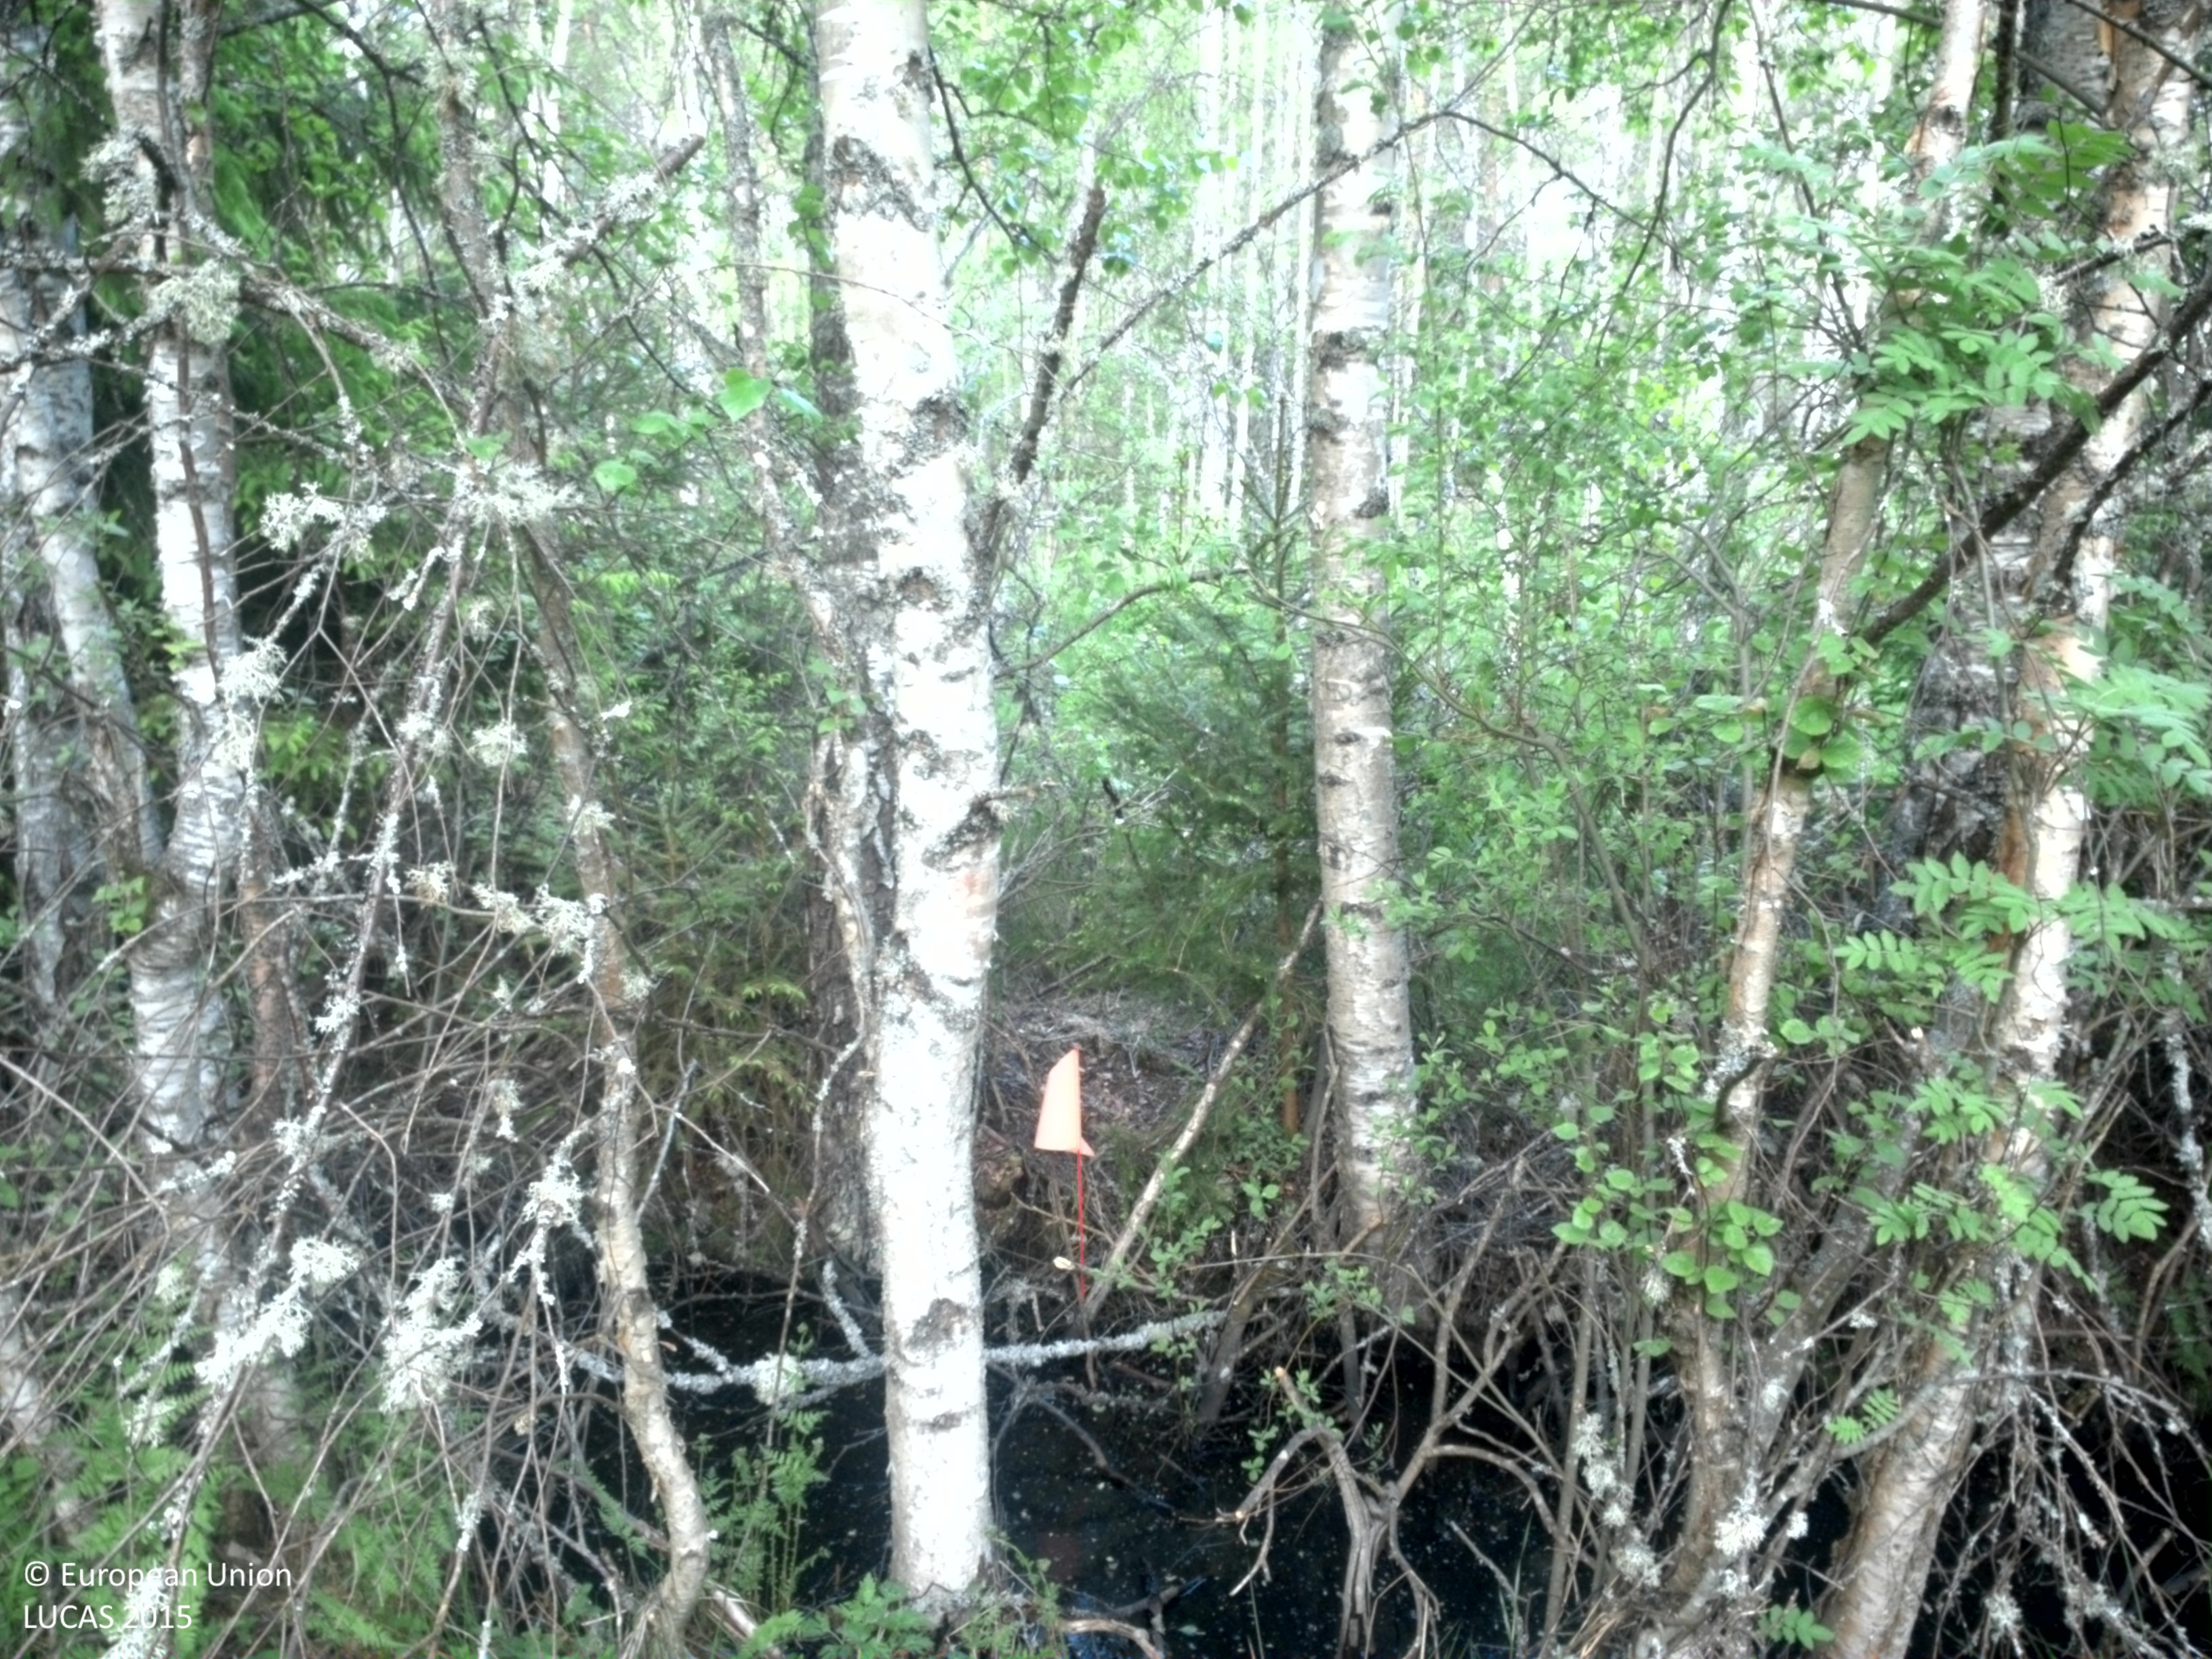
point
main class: Woodland
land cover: Broadleaved woodland
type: boreal forest
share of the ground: 50 - 75 %
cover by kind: broadleaved forest trees 50 %, herbaceous plants 15 %, lichens and mosses 15 %, coniferous forest trees 10 %, shrubs 10 %
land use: Forestry
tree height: > 5 m
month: May
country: SE
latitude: 57.3132
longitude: 15.9252
